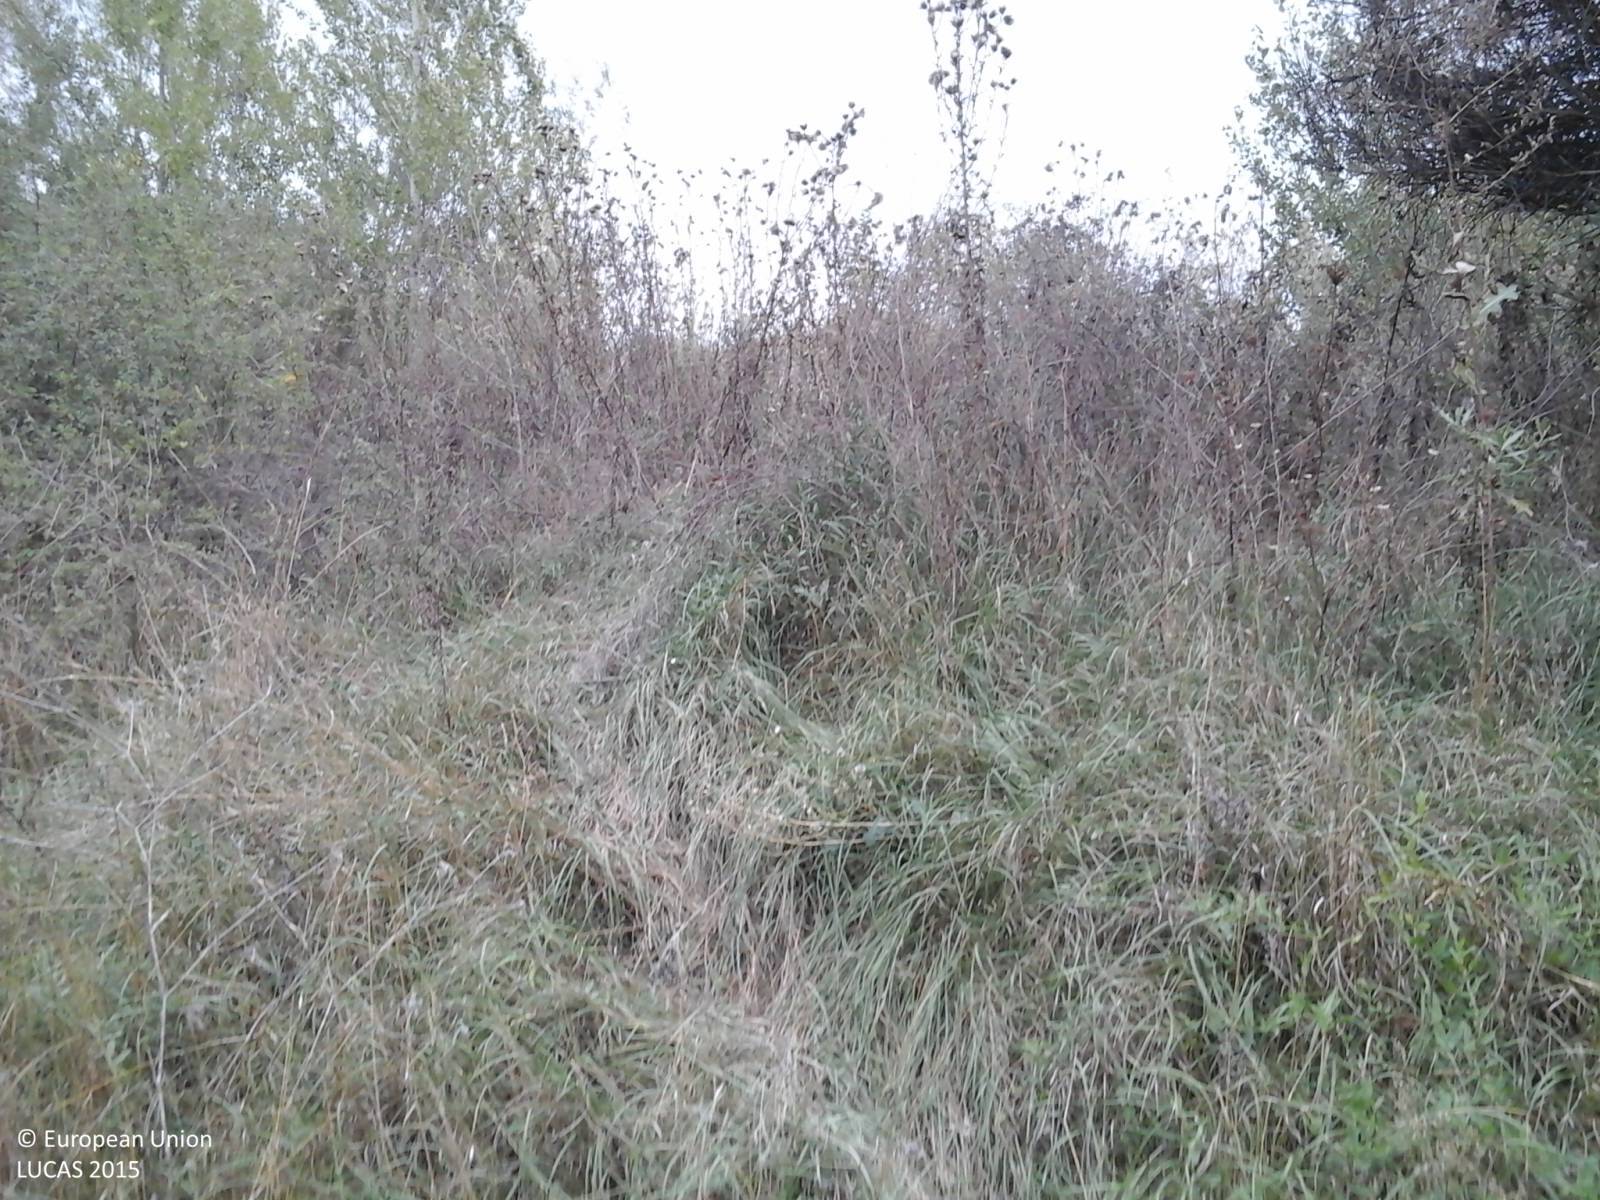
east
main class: Woodland
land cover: Broadleaved woodland
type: thermophilous deciduous forest
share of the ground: > 75 %
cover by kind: broadleaved forest trees 60 %, shrubs 40 %
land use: Forestry
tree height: > 5 m
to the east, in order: Broadleaved woodland; Inland fresh water bodies; Broadleaved woodland; Ditches and canals; Lucerne; Grass margins; Ditches and canals; Grass margins; Lucerne
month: September
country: IT
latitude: 42.9540
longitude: 12.2608
